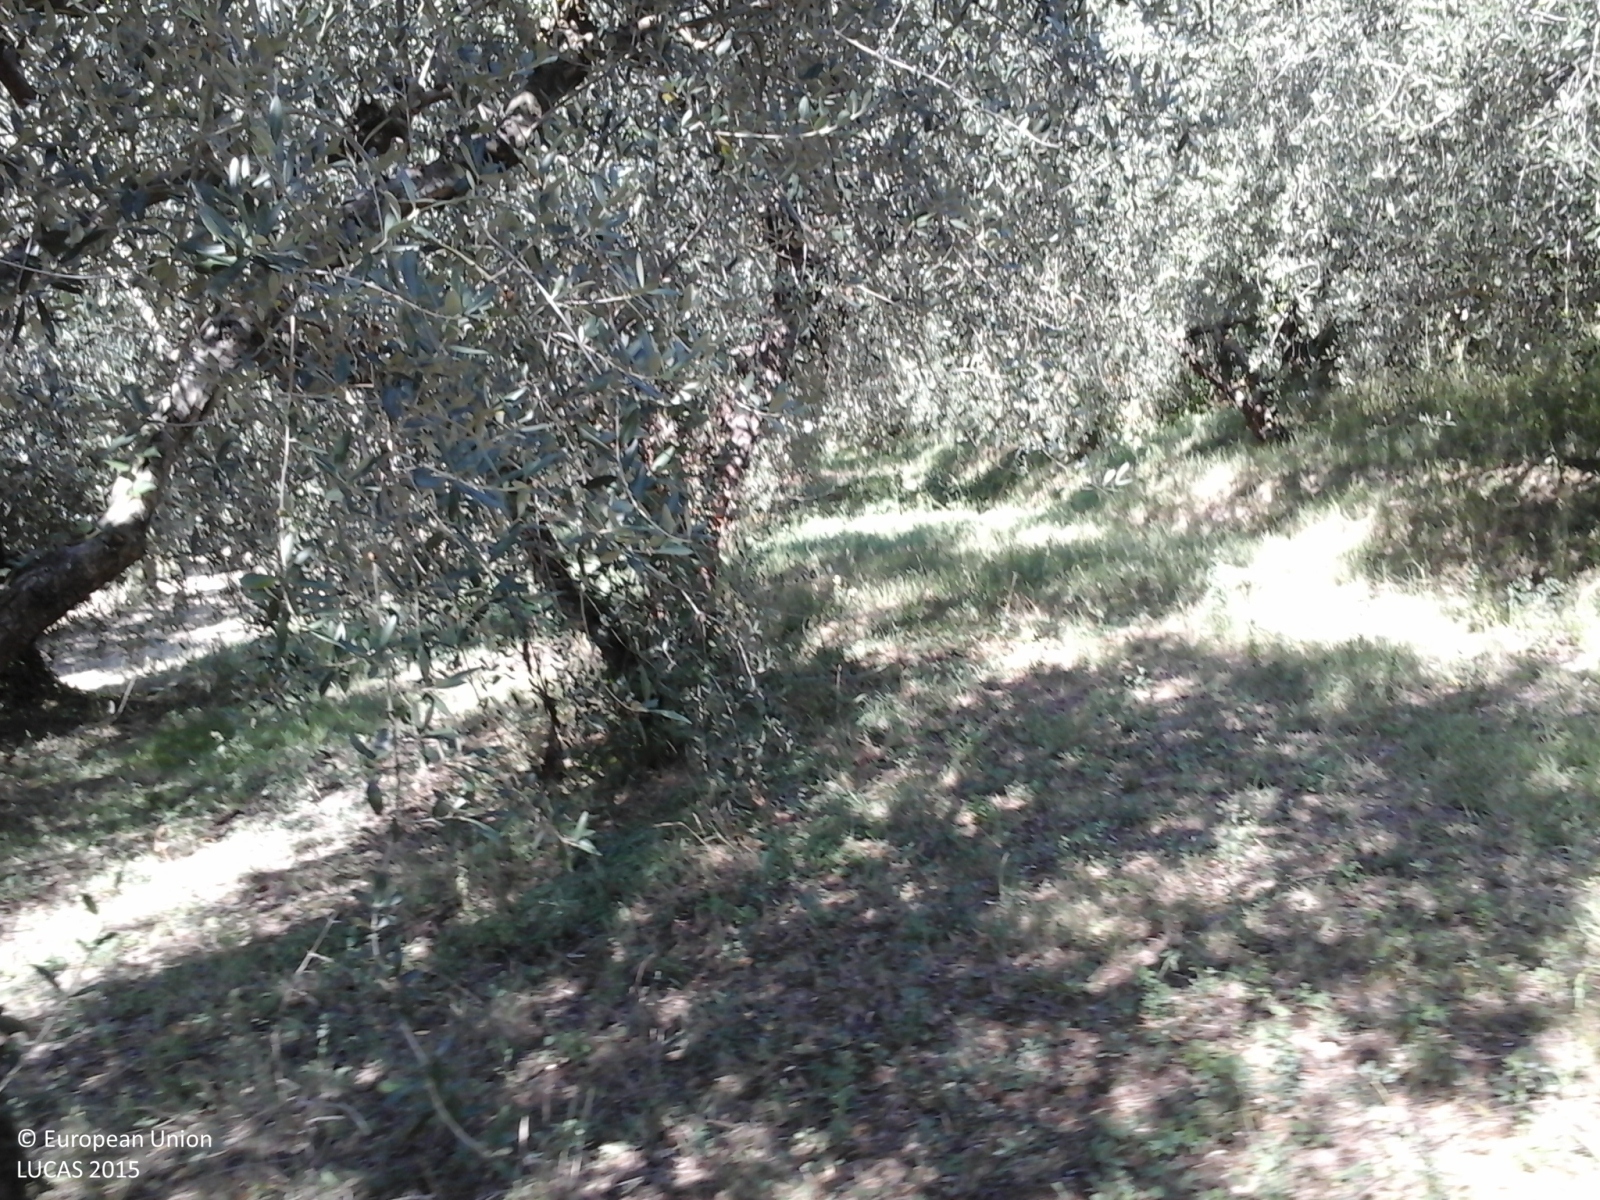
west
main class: Cropland
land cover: Olive groves
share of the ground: > 75 %
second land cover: Grassland without tree/shrub cover
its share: > 75 %
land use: Agriculture (excluding fallow land and kitchen gardens)
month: September
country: IT
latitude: 43.8777
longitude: 12.8682
